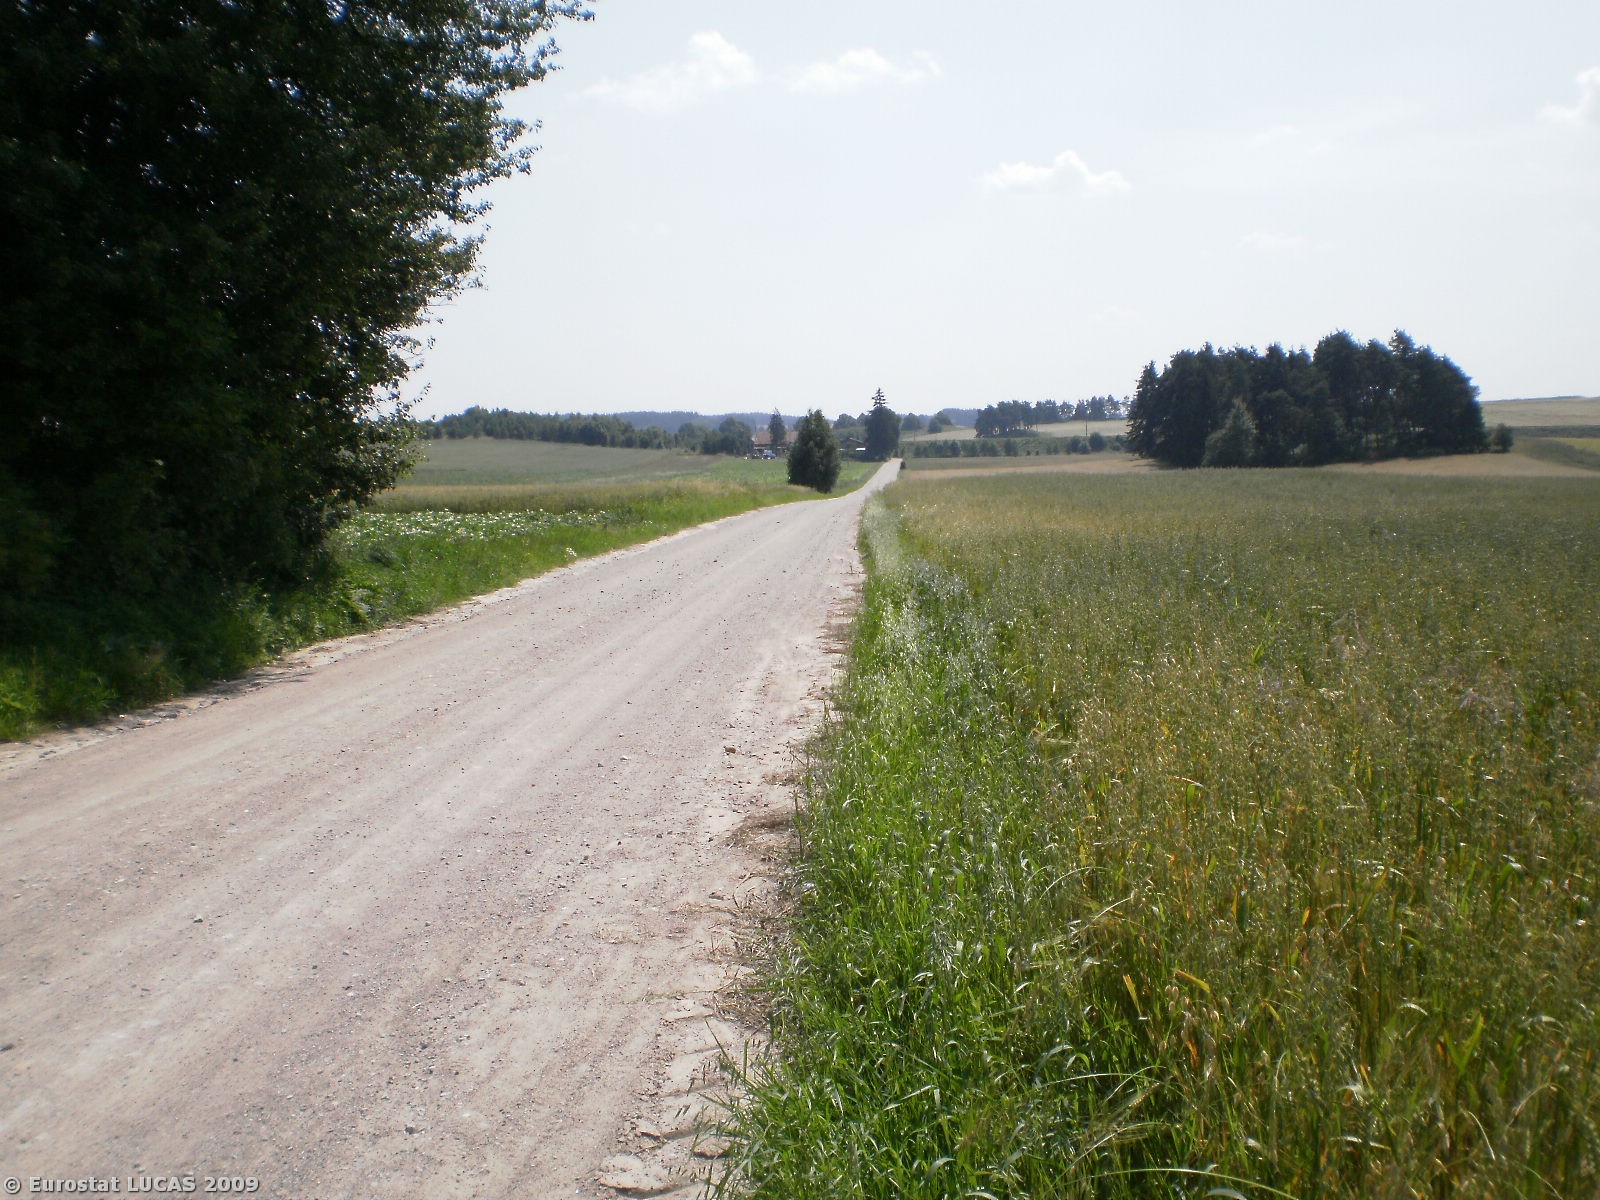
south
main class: Cropland
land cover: Mixed cereals for fodder
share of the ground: > 75 %
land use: Agriculture (excluding fallow land and kitchen gardens)
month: July
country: PL
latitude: 53.3529
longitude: 20.3873
